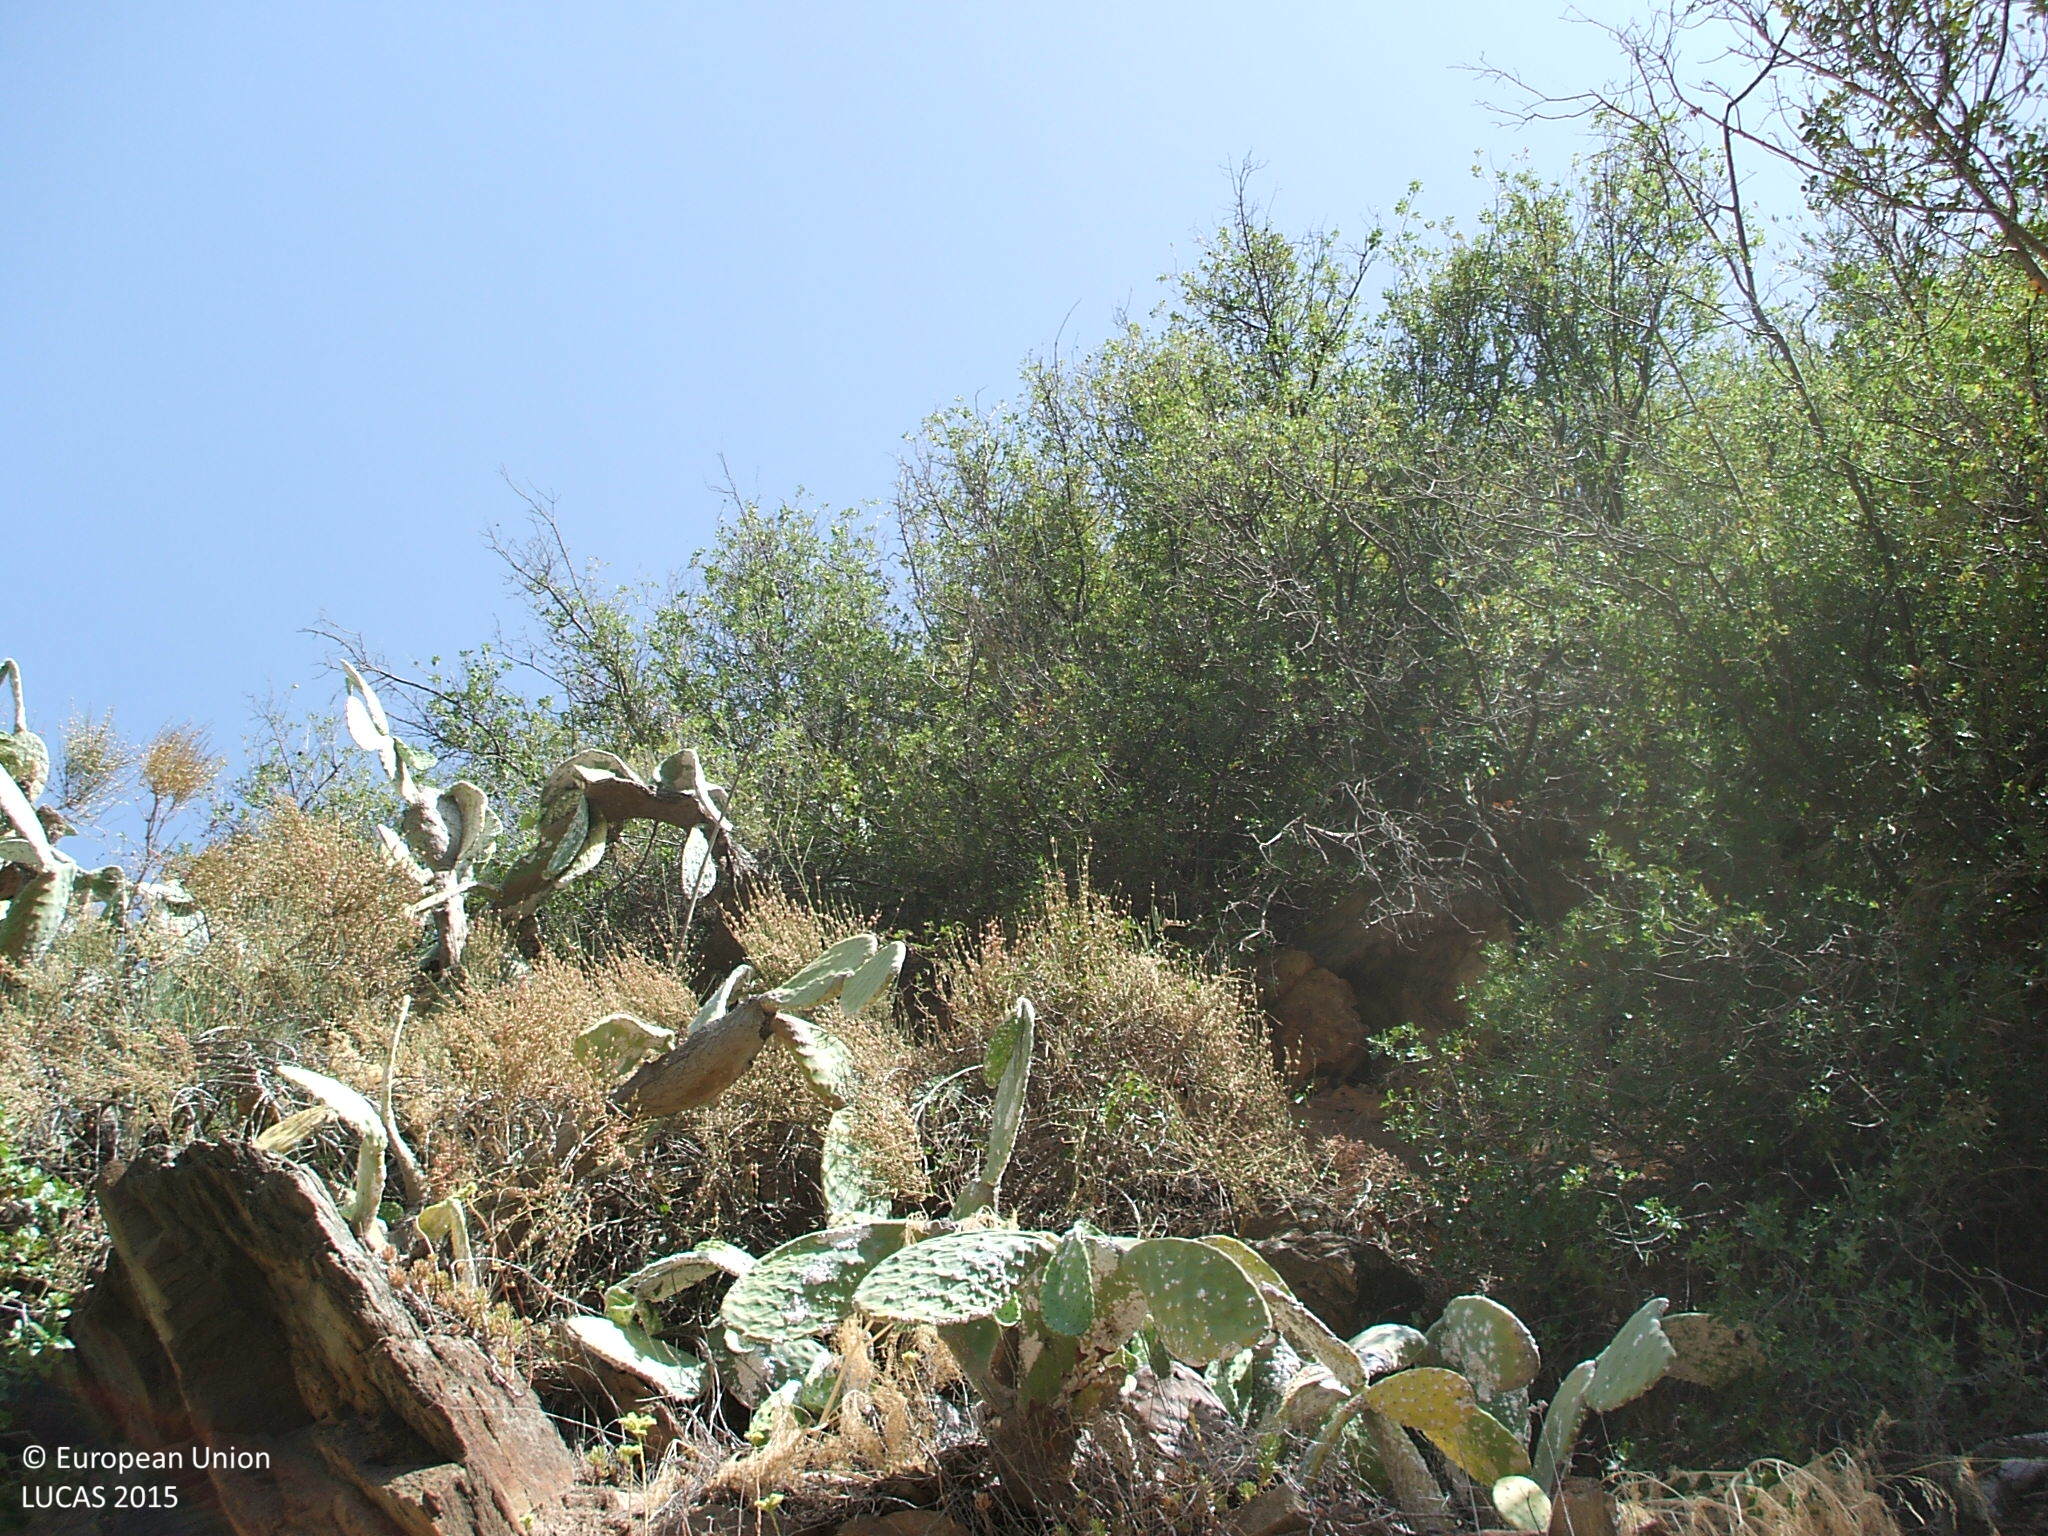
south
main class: Woodland
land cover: Broadleaved woodland
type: broadleaved evergreen forest
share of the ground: 10 - 25 %
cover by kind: herbaceous plants 70 %, broadleaved forest trees 15 %, shrubs 15 %
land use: Semi-natural and natural areas not in use
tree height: > 5 m
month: July
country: ES
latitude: 37.2897
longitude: -2.3326
